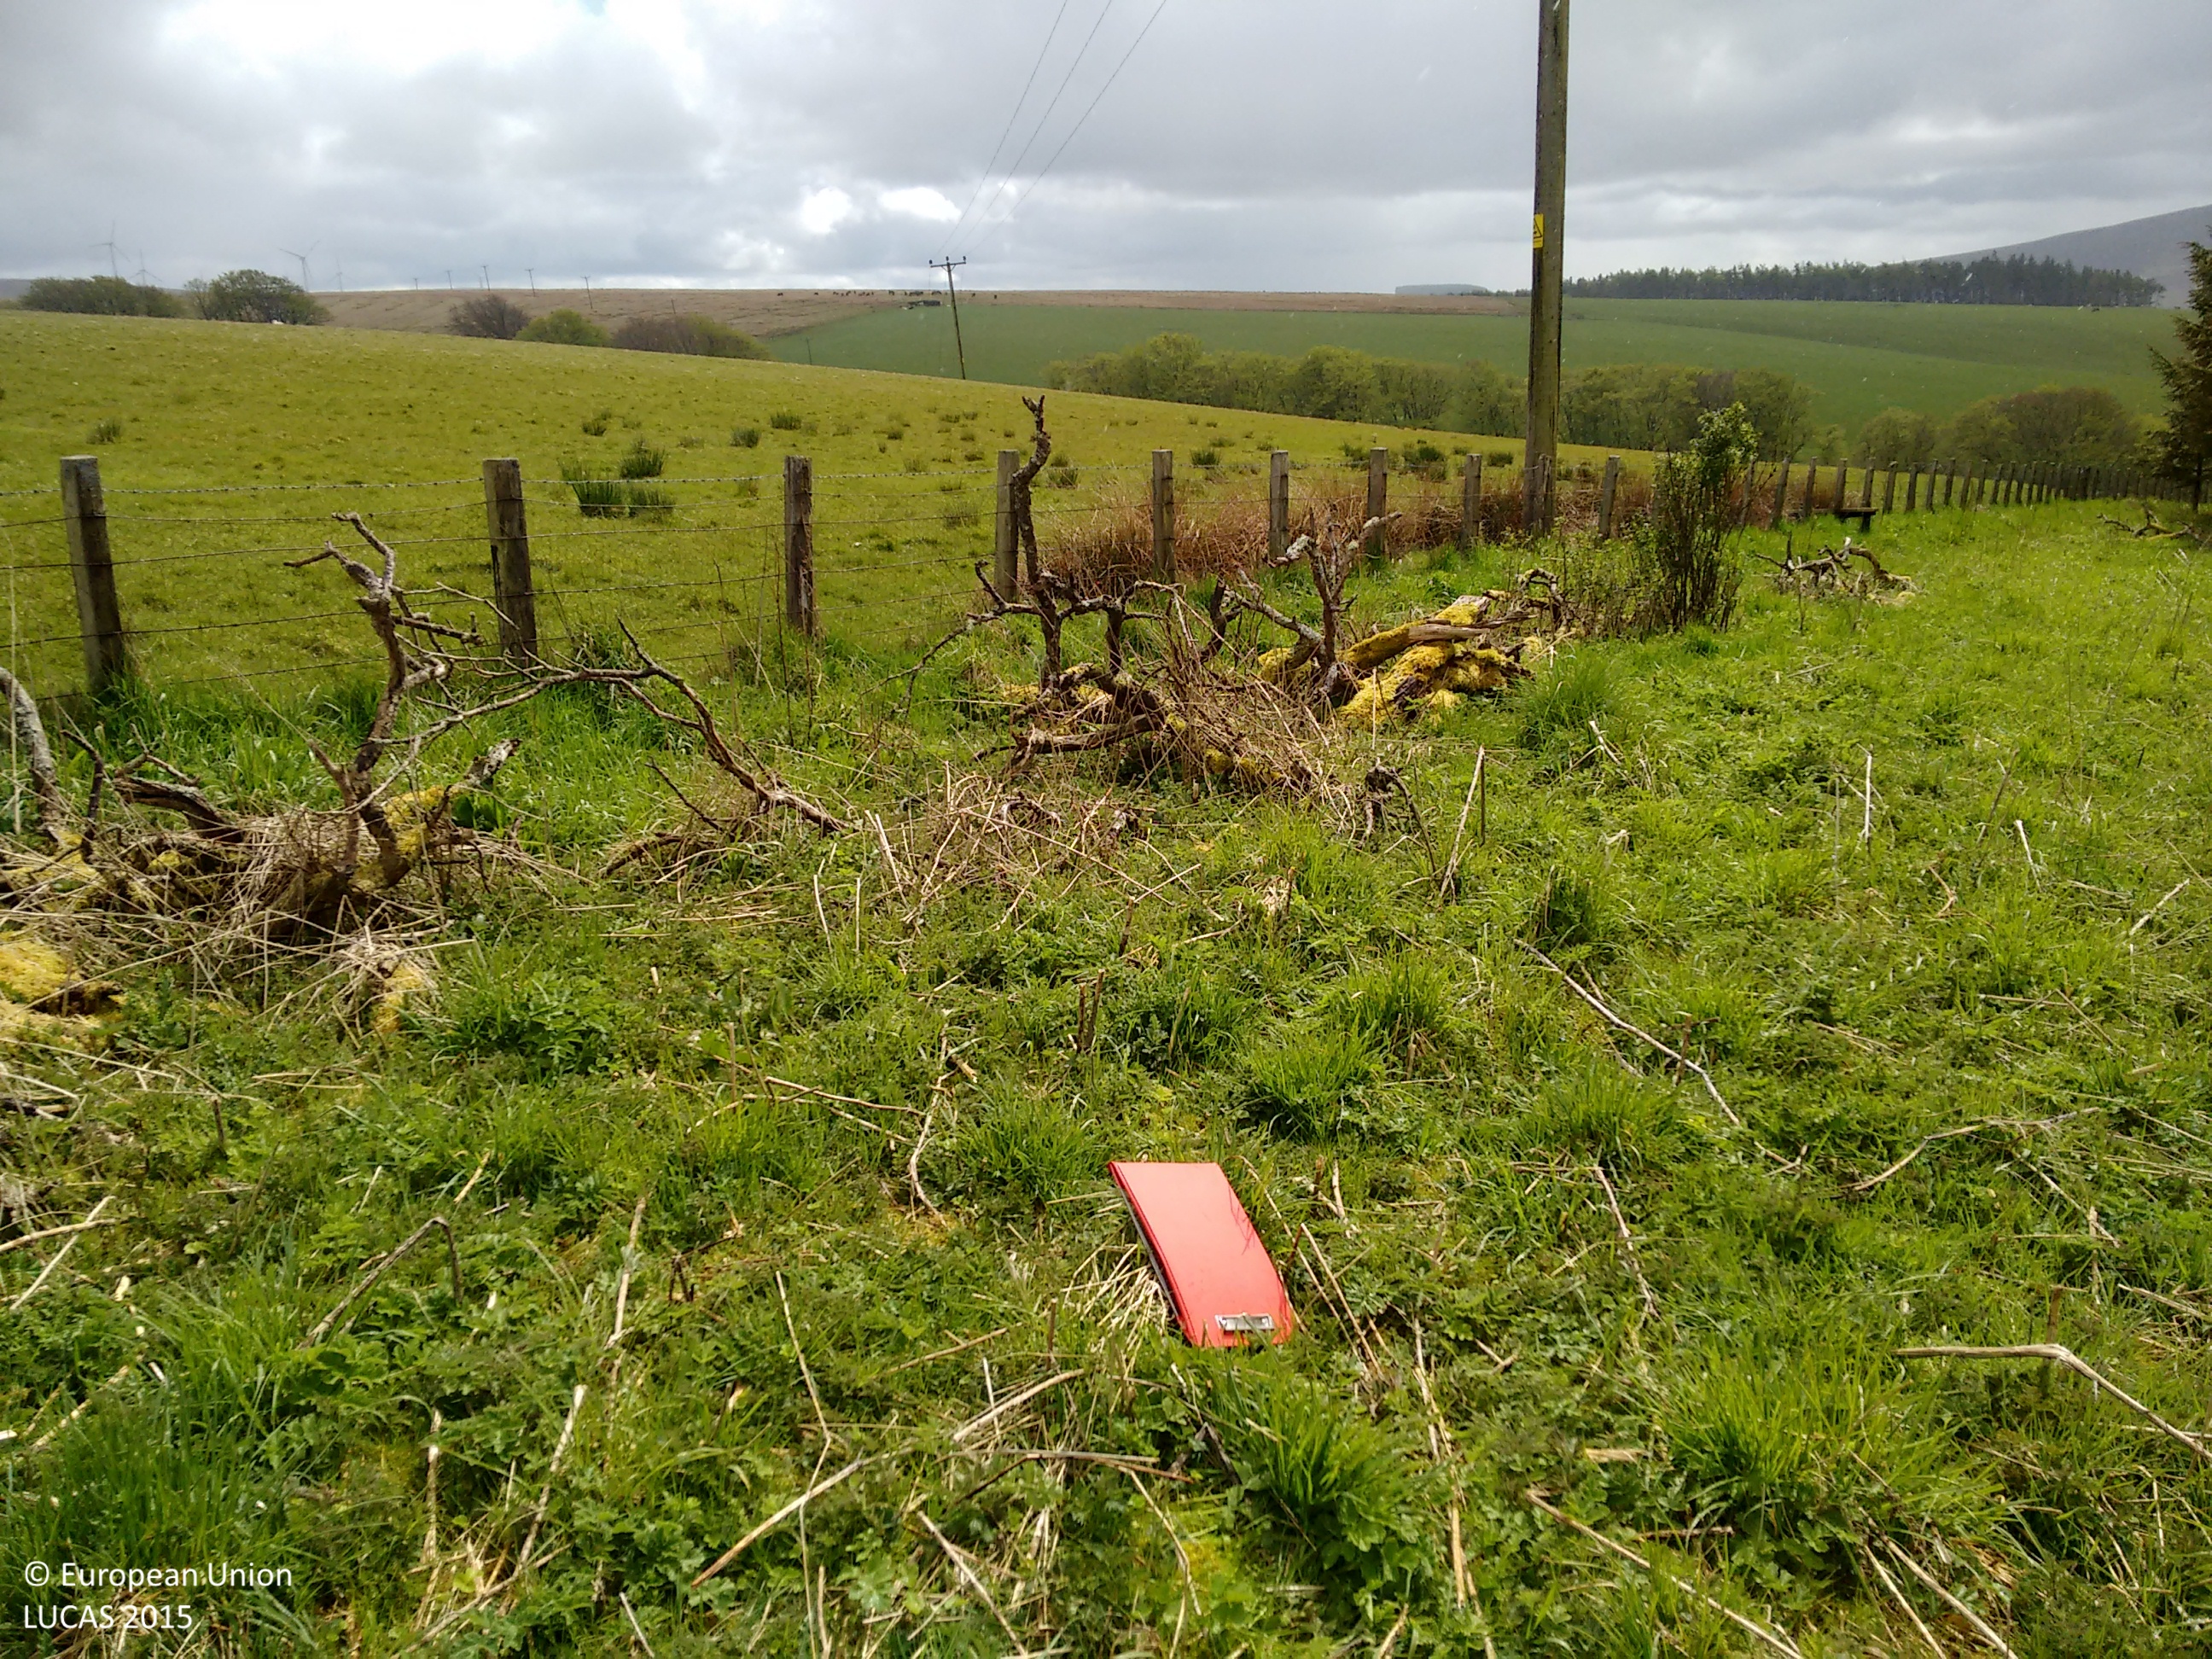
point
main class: Grassland
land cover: Spontaneously vegetated surfaces
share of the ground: > 75 %
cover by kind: herbaceous plants 95 %, shrubs 5 %
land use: Fallow land
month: May
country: GB
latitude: 55.8144
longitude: -2.4588
